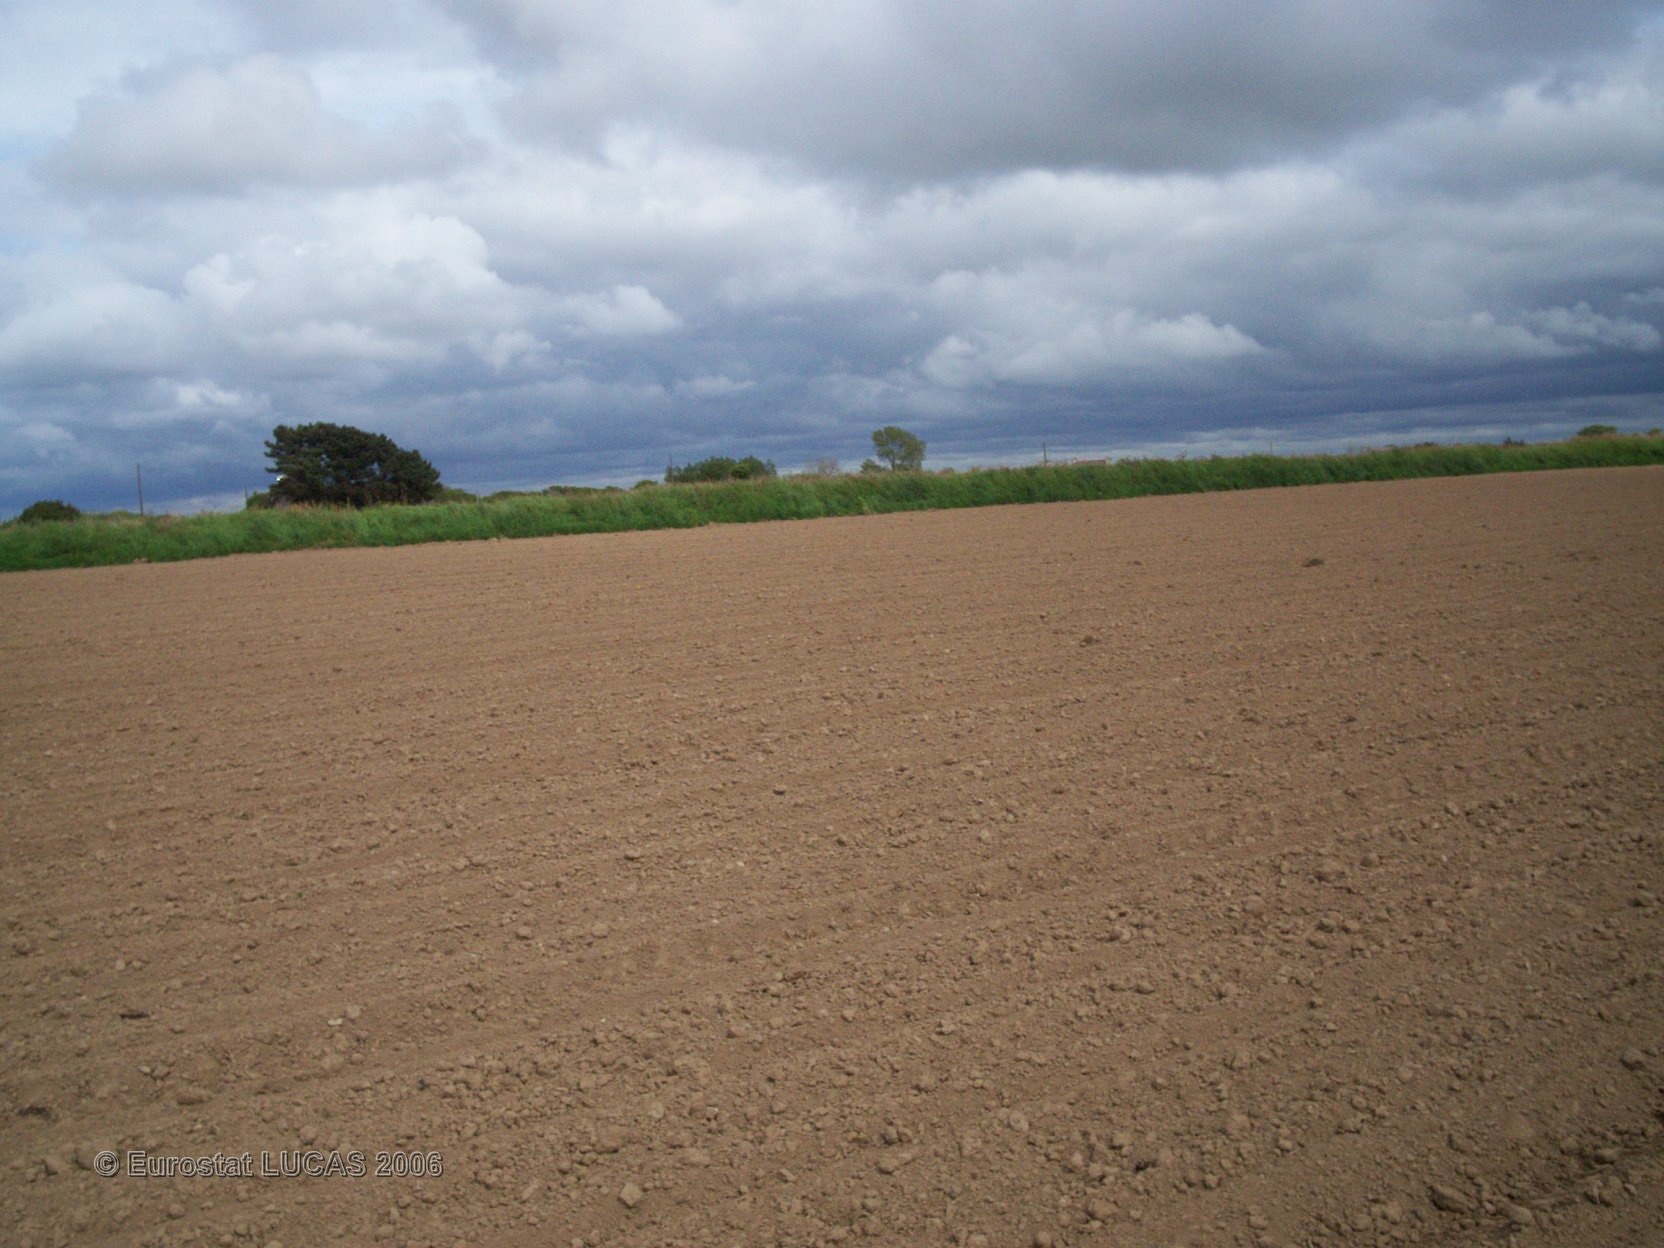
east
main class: Cropland
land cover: Maize
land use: Agriculture (excluding fallow land and kitchen gardens)
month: May
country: FR
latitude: 48.6731
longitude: -3.7320
